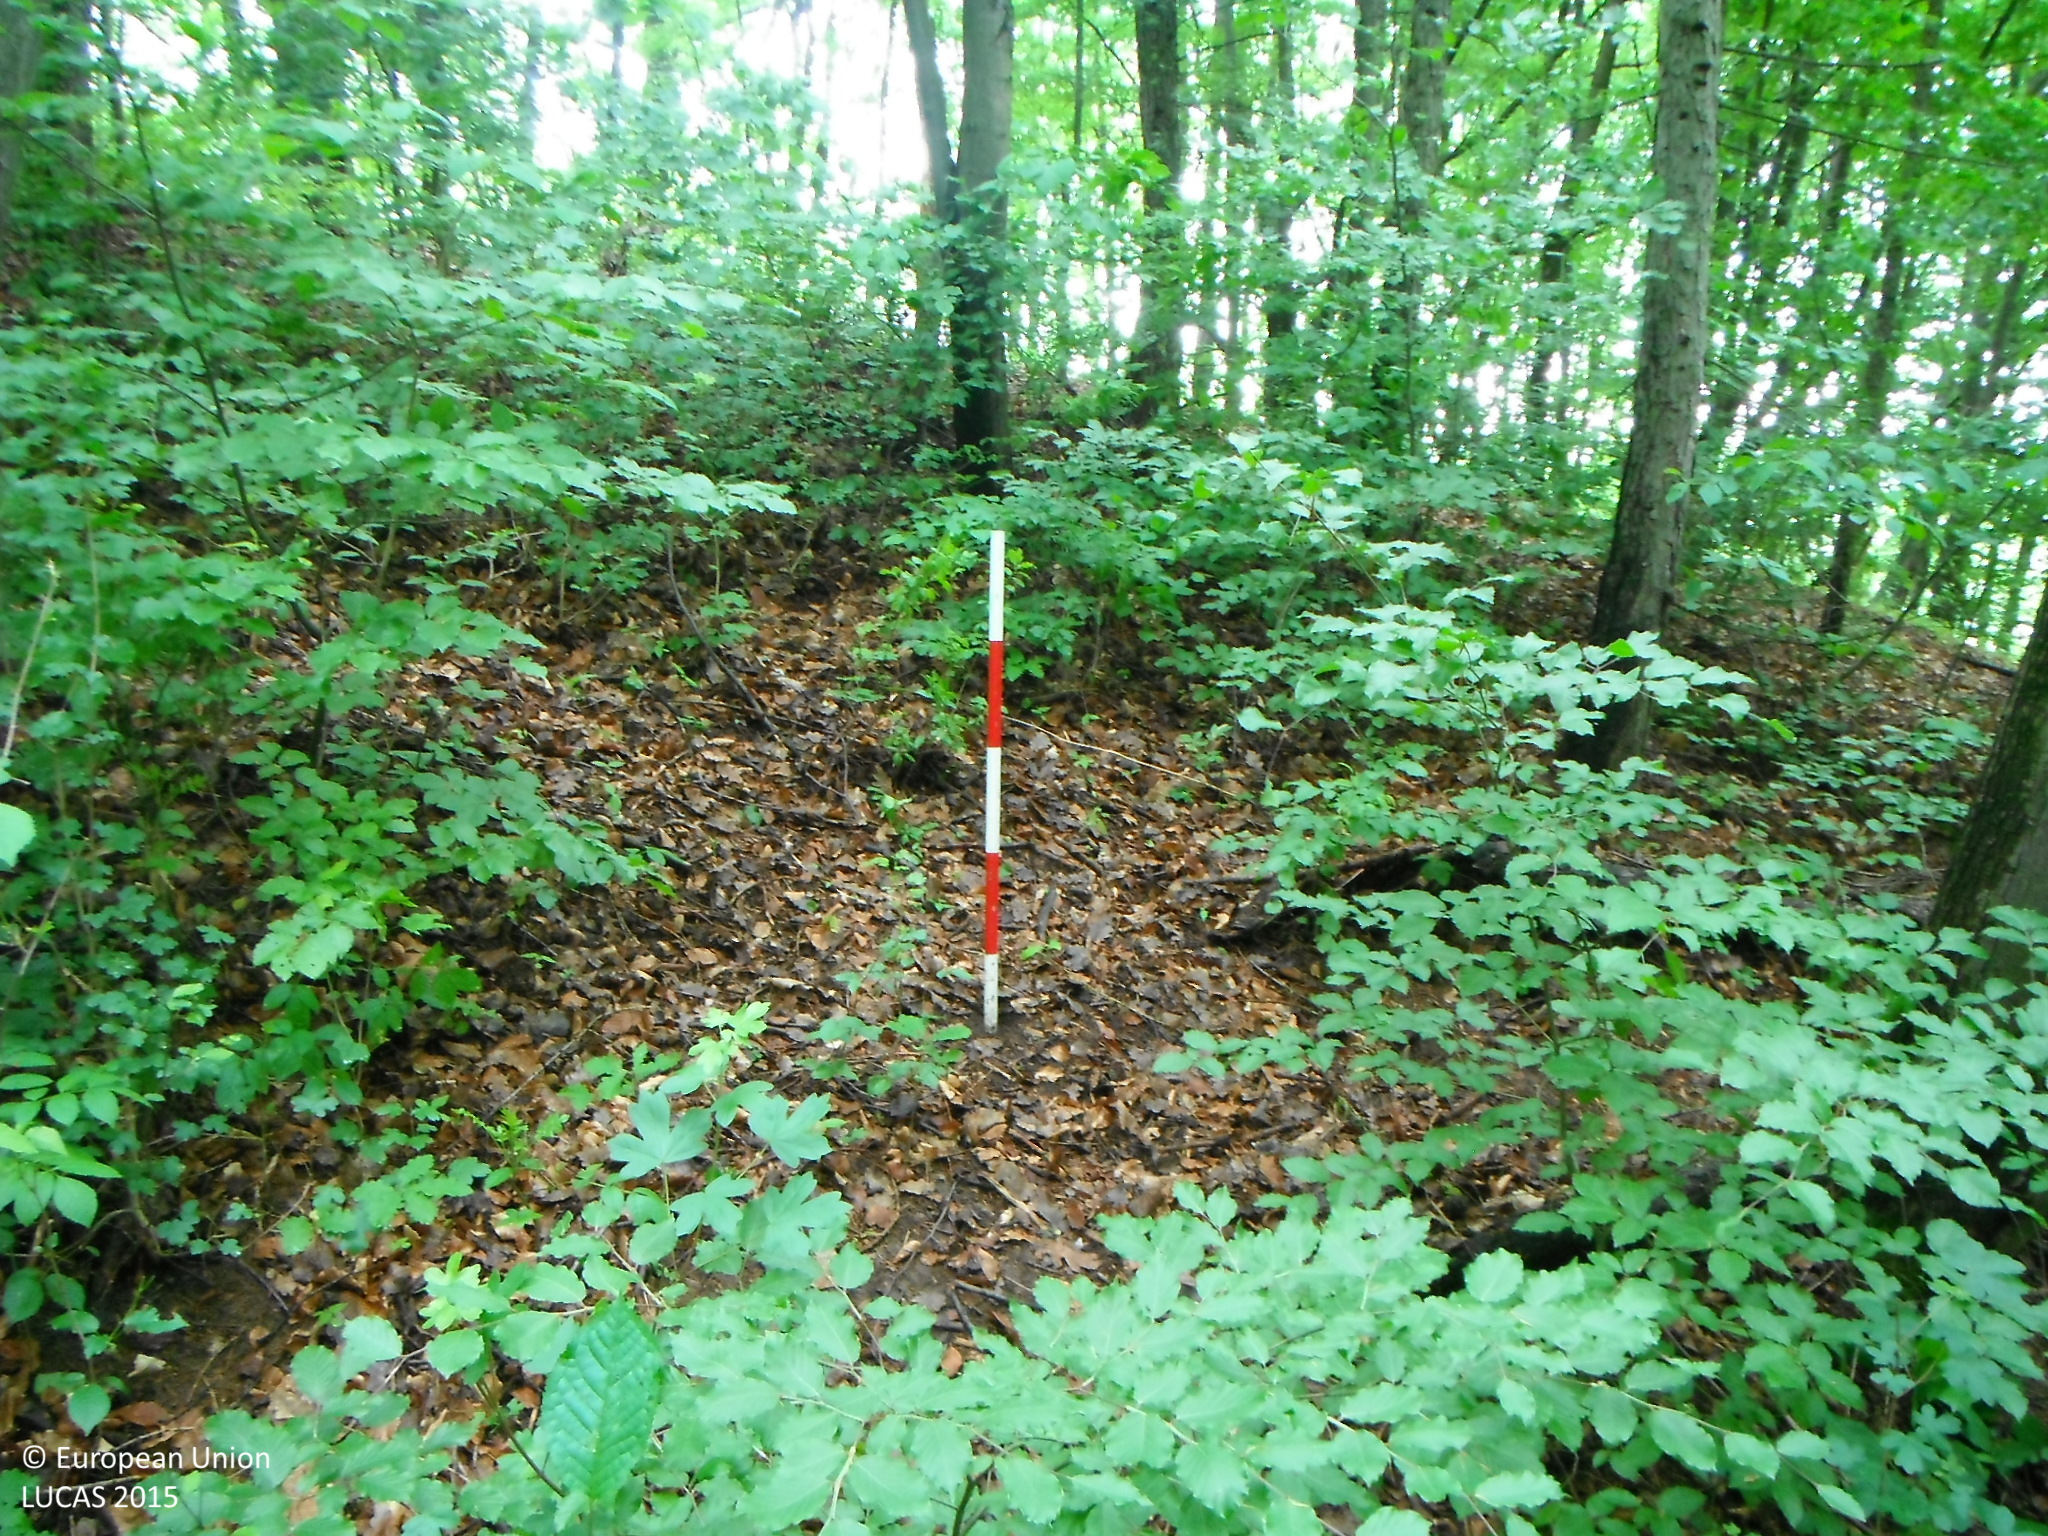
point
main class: Woodland
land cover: Other mixed woodland
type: hemiboreal forest and nemoral coniferous forest and mixed broadleaved-coniferous forest
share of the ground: > 75 %
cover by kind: broadleaved forest trees 60 %, coniferous forest trees 40 %
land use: Forestry
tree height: > 5 m
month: May
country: SK
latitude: 48.7300
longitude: 19.1448
